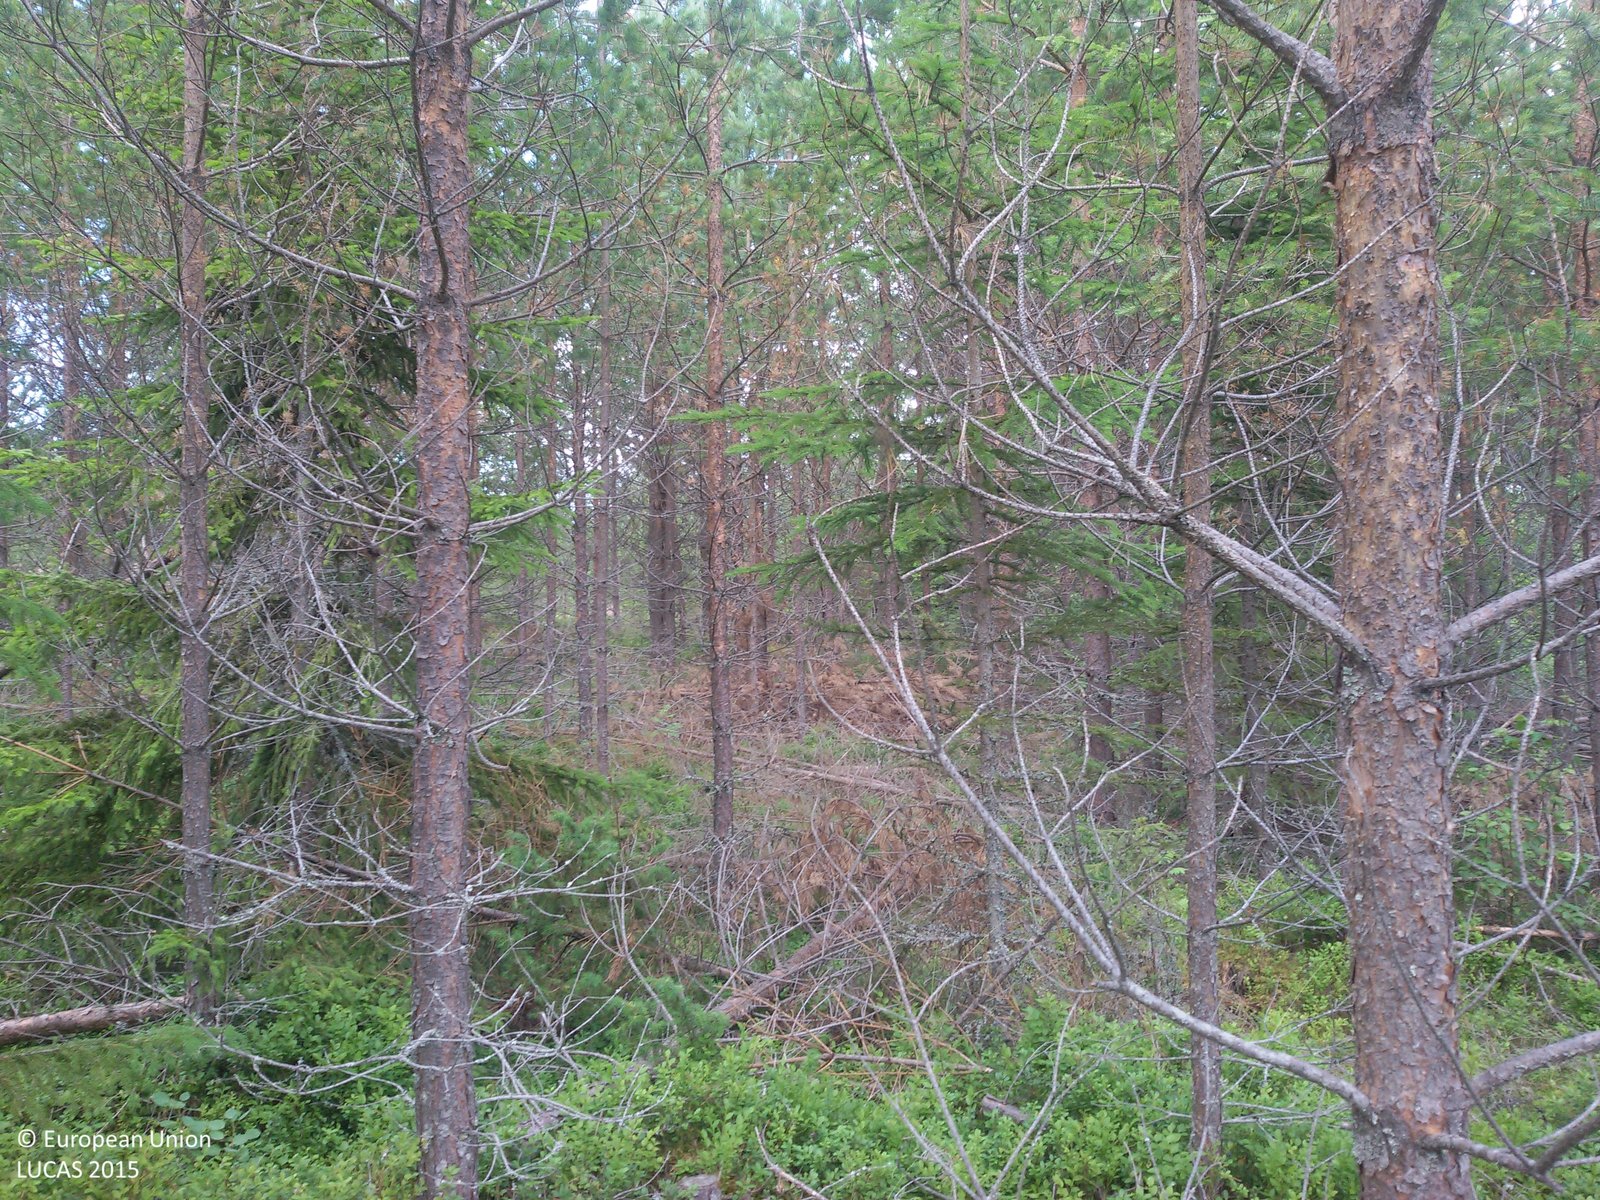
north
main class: Woodland
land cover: Pine dominated coniferous woodland
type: boreal forest
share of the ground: > 75 %
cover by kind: coniferous forest trees 80 %, herbaceous plants 20 %
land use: Forestry
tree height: > 5 m
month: July
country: SE
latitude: 60.5905
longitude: 15.1905
